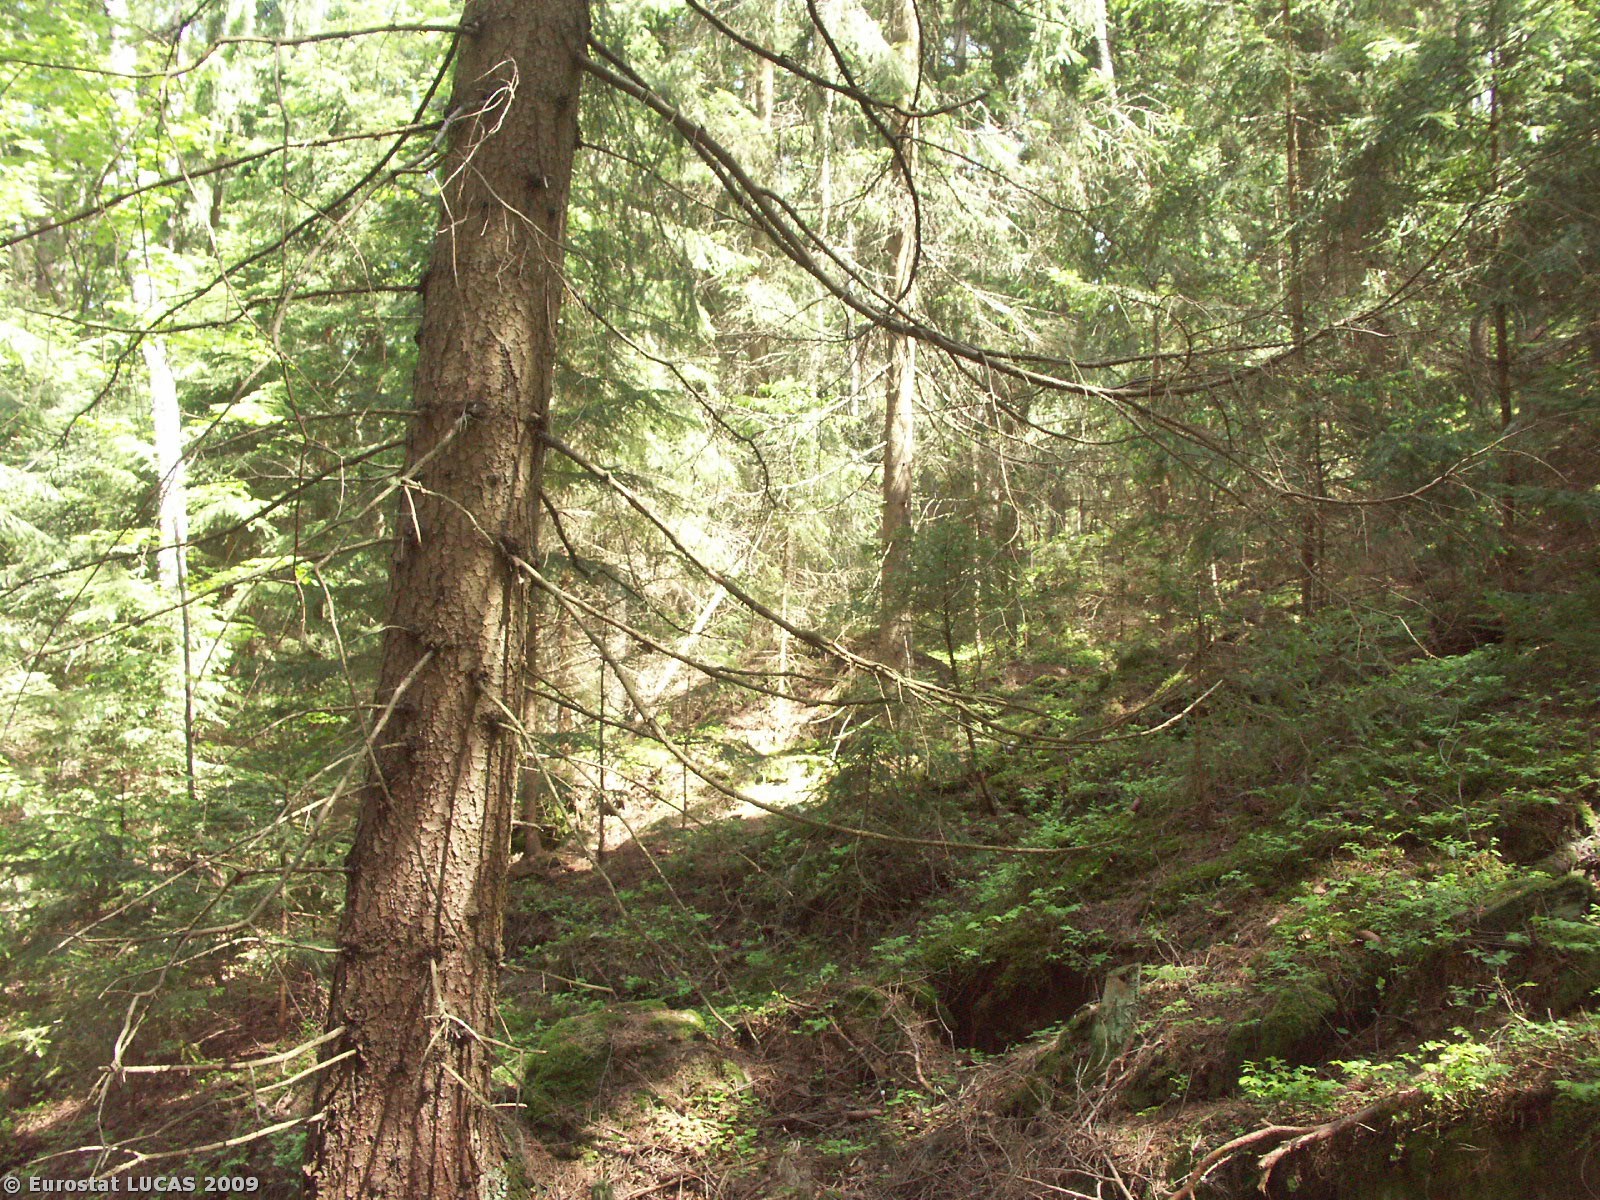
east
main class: Woodland
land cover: Coniferous woodland
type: hemiboreal forest and nemoral coniferous forest and mixed broadleaved-coniferous forest
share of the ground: > 75 %
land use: Forestry
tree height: > 5 m
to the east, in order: Coniferous woodland; Rock outcrops; Mixed woodland; Tracks; Mixed woodland; Rivers and streams; Mixed woodland; Coniferous woodland
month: May
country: CZ
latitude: 48.7028
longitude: 14.6346
